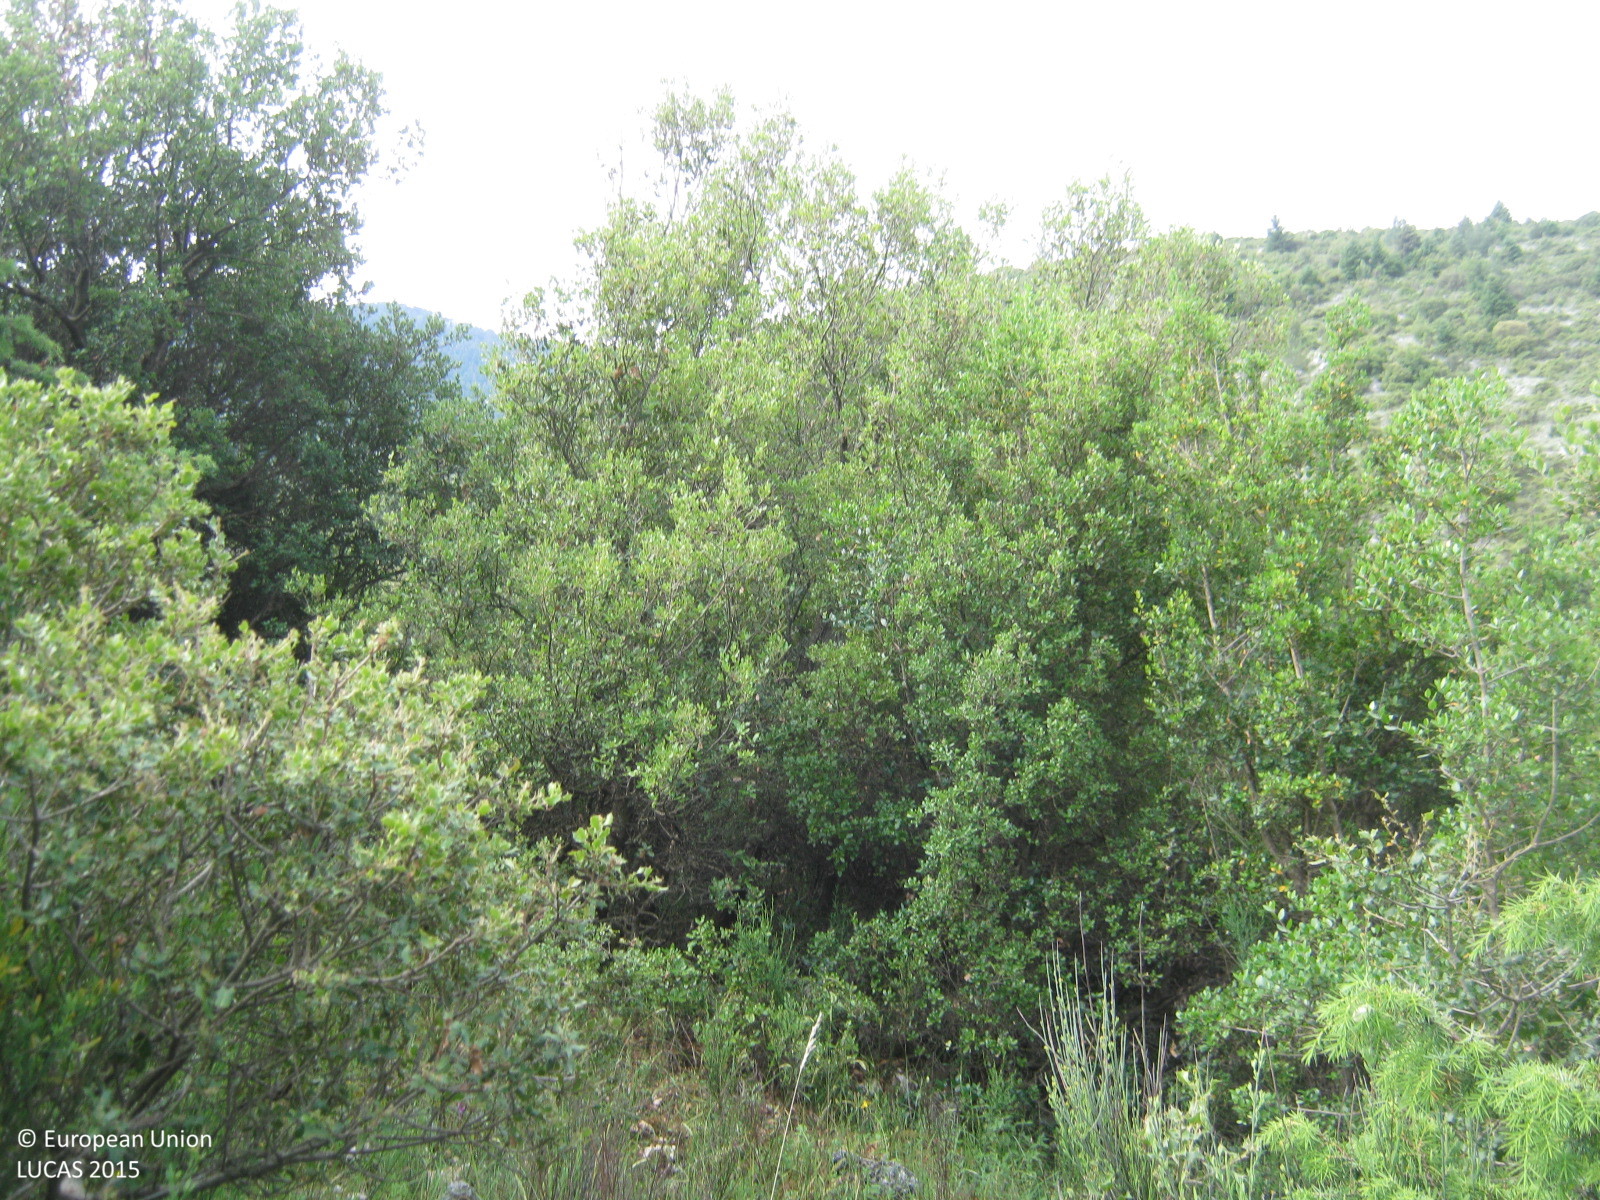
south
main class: Shrubland
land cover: Shrubland with sparse tree cover
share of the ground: > 75 %
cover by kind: shrubs 80 %, consolidated bare surface 10 %, broadleaved forest trees 5 %, herbaceous plants 5 %
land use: Semi-natural and natural areas not in use
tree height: > 5 m
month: June
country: GR
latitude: 39.4968
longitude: 20.5453
